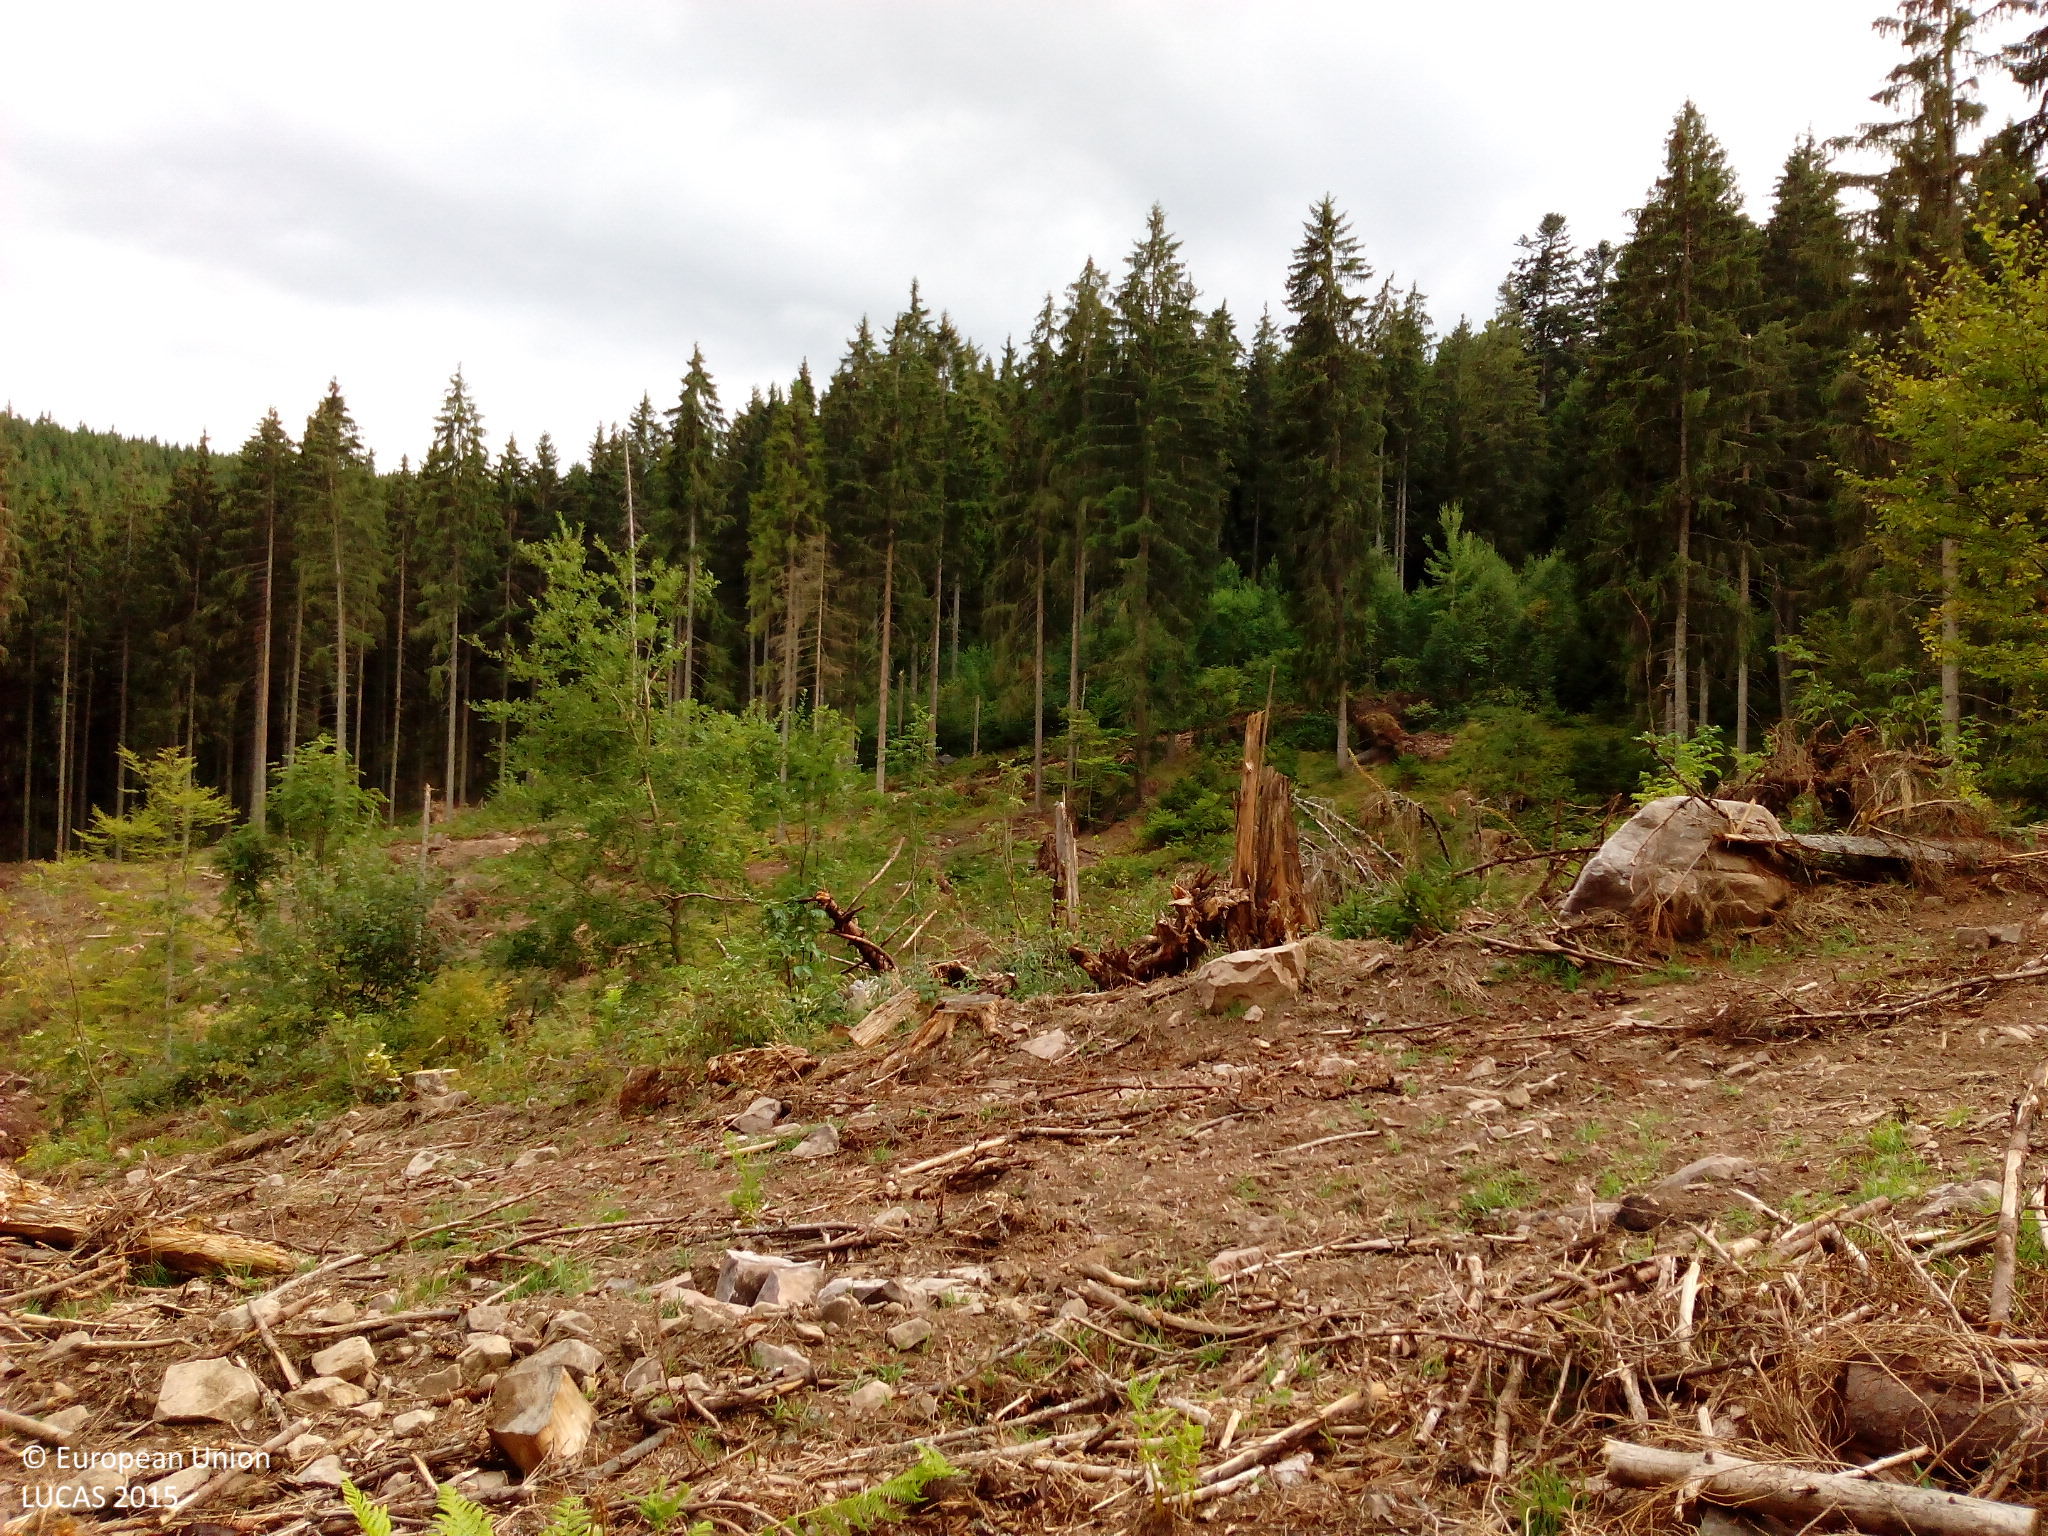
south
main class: Grassland
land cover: Spontaneously vegetated surfaces
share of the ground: 10 - 25 %
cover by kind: unconsolidated bare surface 75 %, herbaceous plants 15 %, shrubs 5 %
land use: Forestry
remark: Clear cut
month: August
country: DE
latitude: 47.8488
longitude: 8.1971
